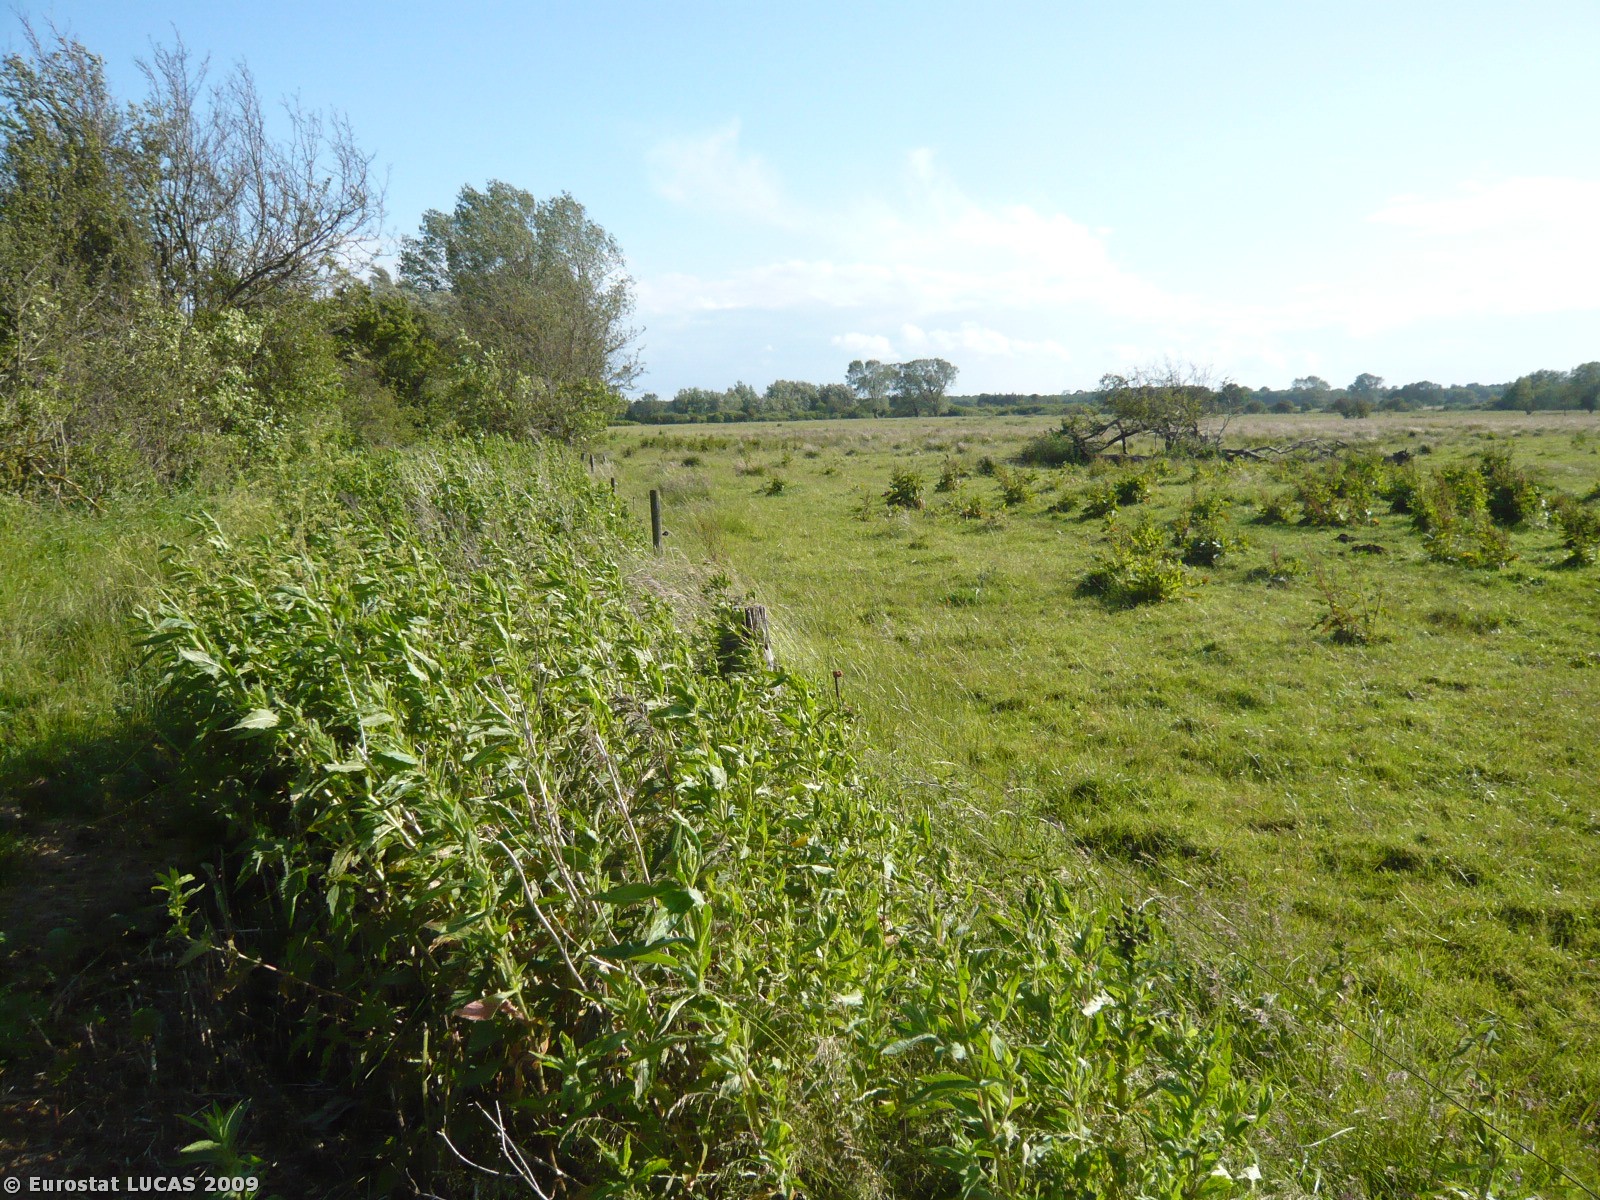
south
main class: Wetlands
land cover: Inland marshes
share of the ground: > 75 %
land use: Unused
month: June
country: DK
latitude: 54.6861
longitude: 11.5657
